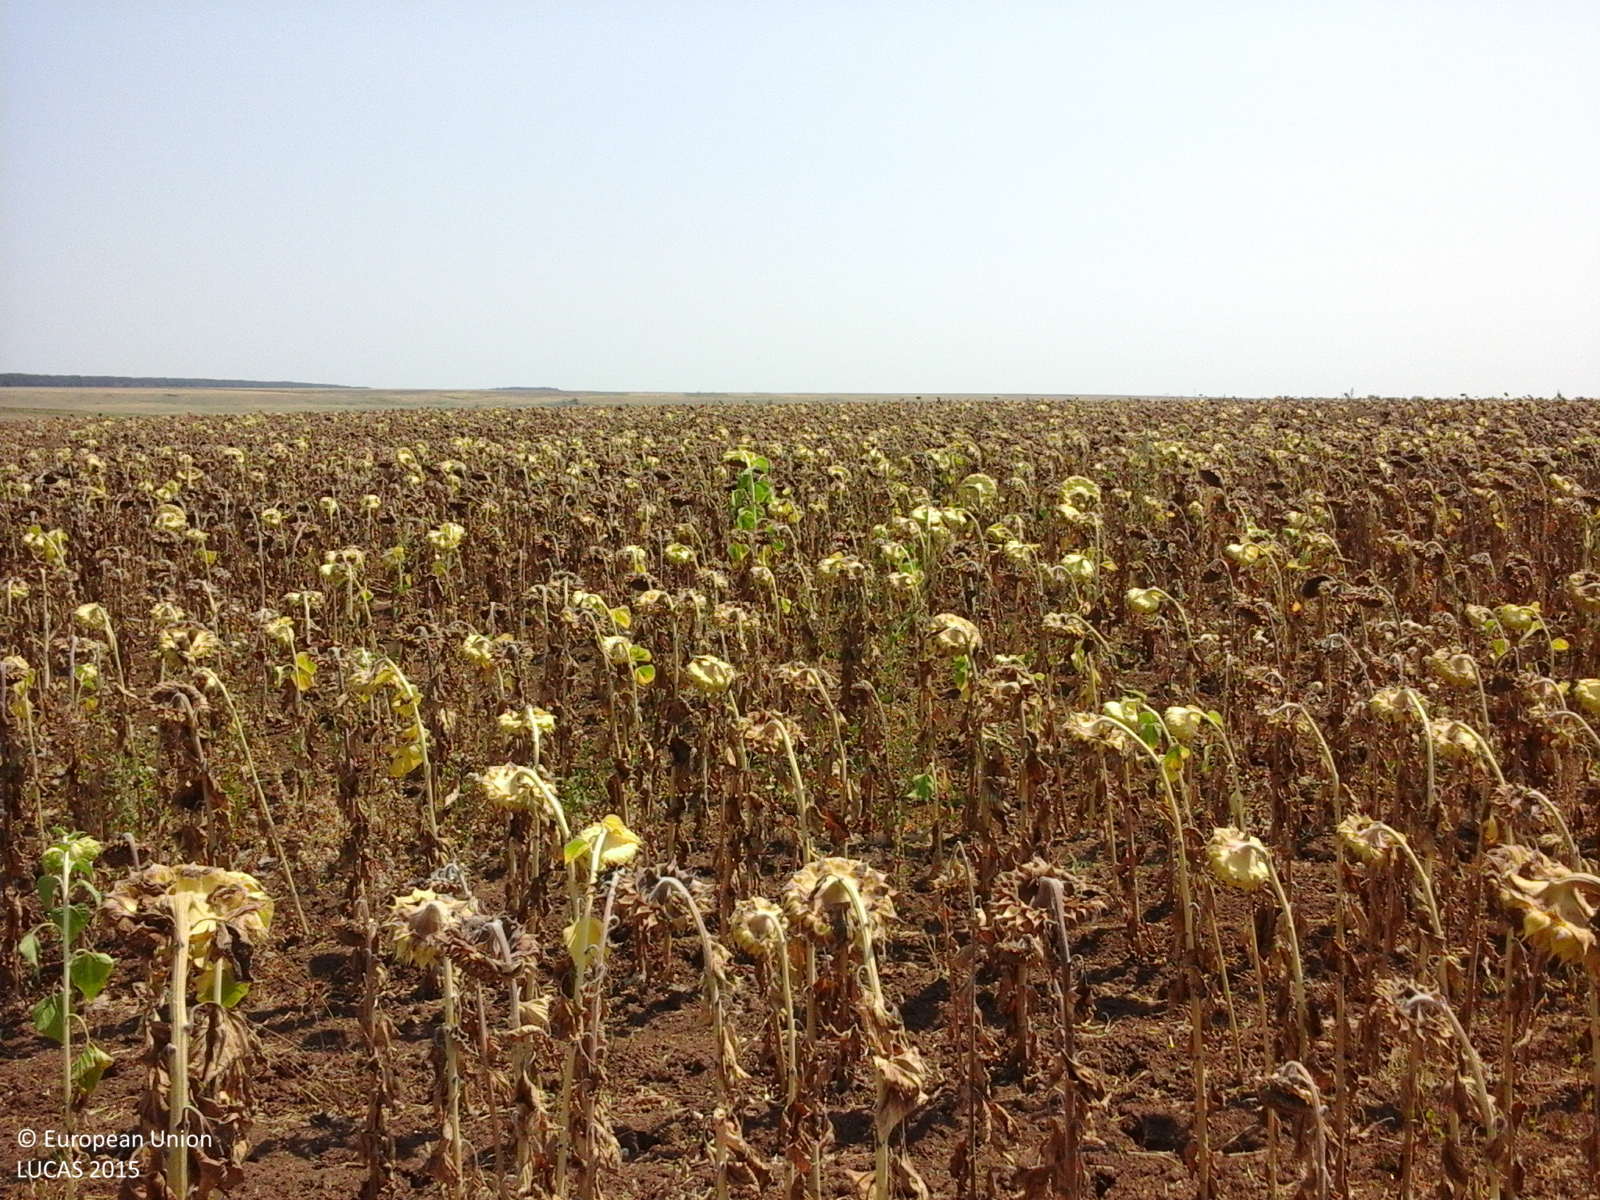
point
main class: Cropland
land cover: Sunflower
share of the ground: > 75 %
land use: Agriculture (excluding fallow land and kitchen gardens)
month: August
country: RO
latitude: 44.2377
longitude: 23.3078
